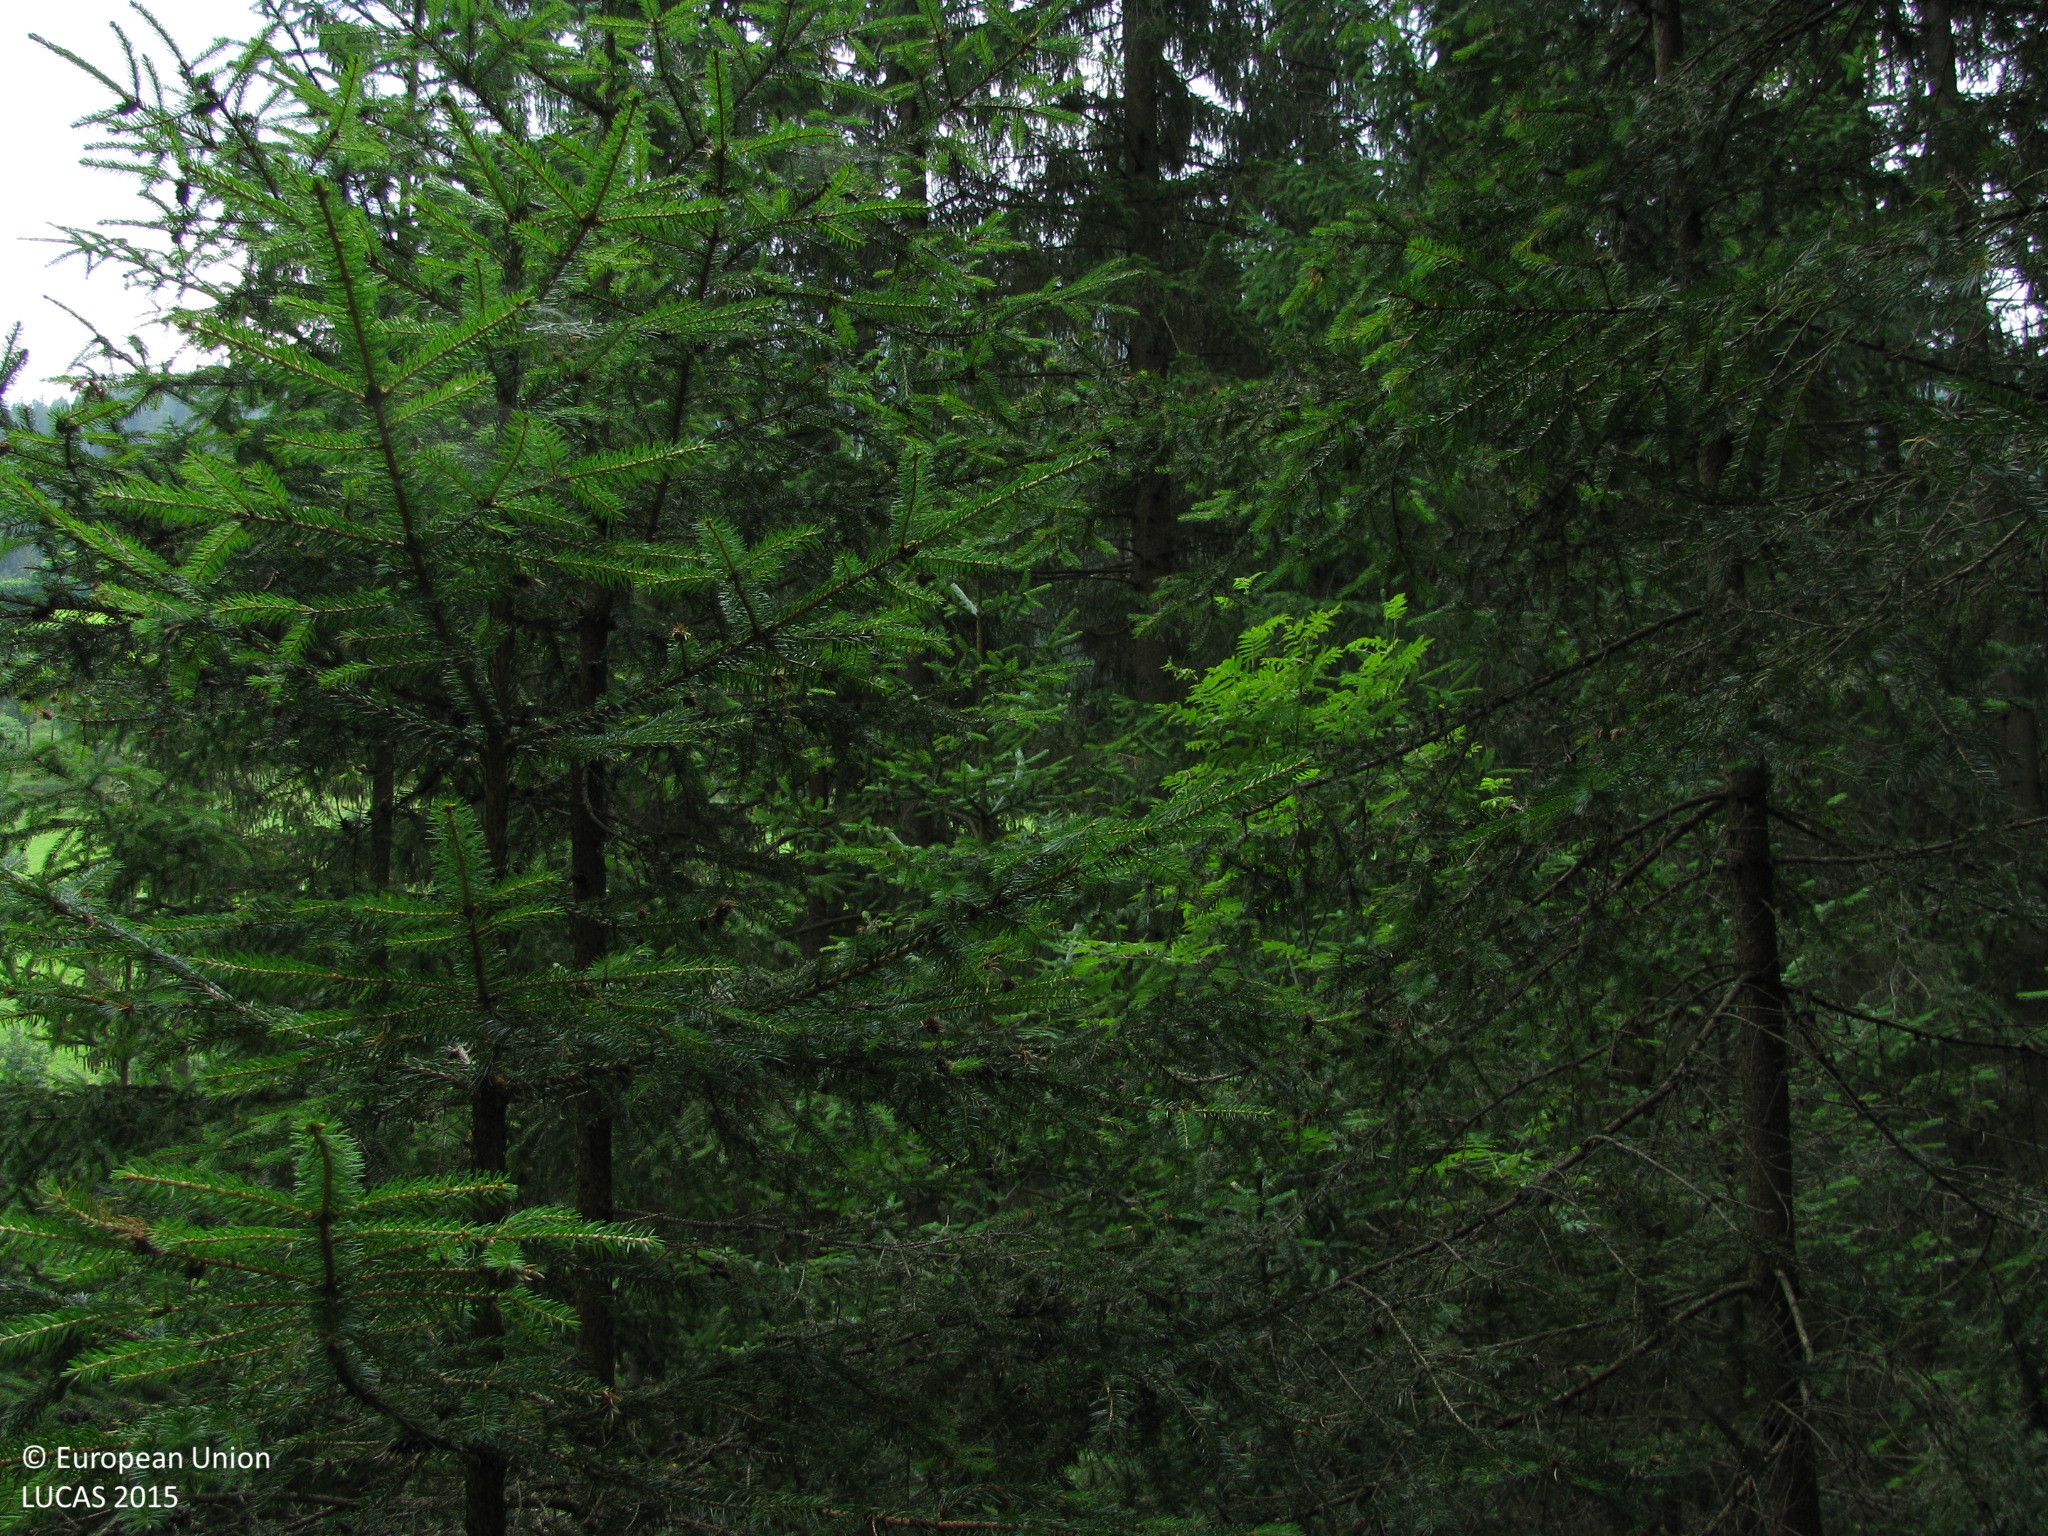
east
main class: Woodland
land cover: Spruce dominated coniferous woodland
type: alpine coniferous forest
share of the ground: > 75 %
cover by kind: coniferous forest trees 70 %, herbaceous plants 25 %, lichens and mosses 5 %
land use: Forestry
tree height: > 5 m
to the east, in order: Spruce dominated coniferous woodland; Tracks; Spruce dominated coniferous woodland; Rivers and streams; Spruce dominated mixed woodland; Rivers and streams; Spruce dominated coniferous woodland; Tracks; Spruce dominated mixed woodland; Fences; Grassland without tree/shrub cover; Fences; Grassland without tree/shrub cover; Fences; Grassland with sparse tree/shrub cover; Electric lines; Grassland with sparse tree/shrub cover; Fences; Tracks; Grassland with sparse tree/shrub cover; Grassland without tree/shrub cover
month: July
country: AT
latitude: 47.1124
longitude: 14.7300
